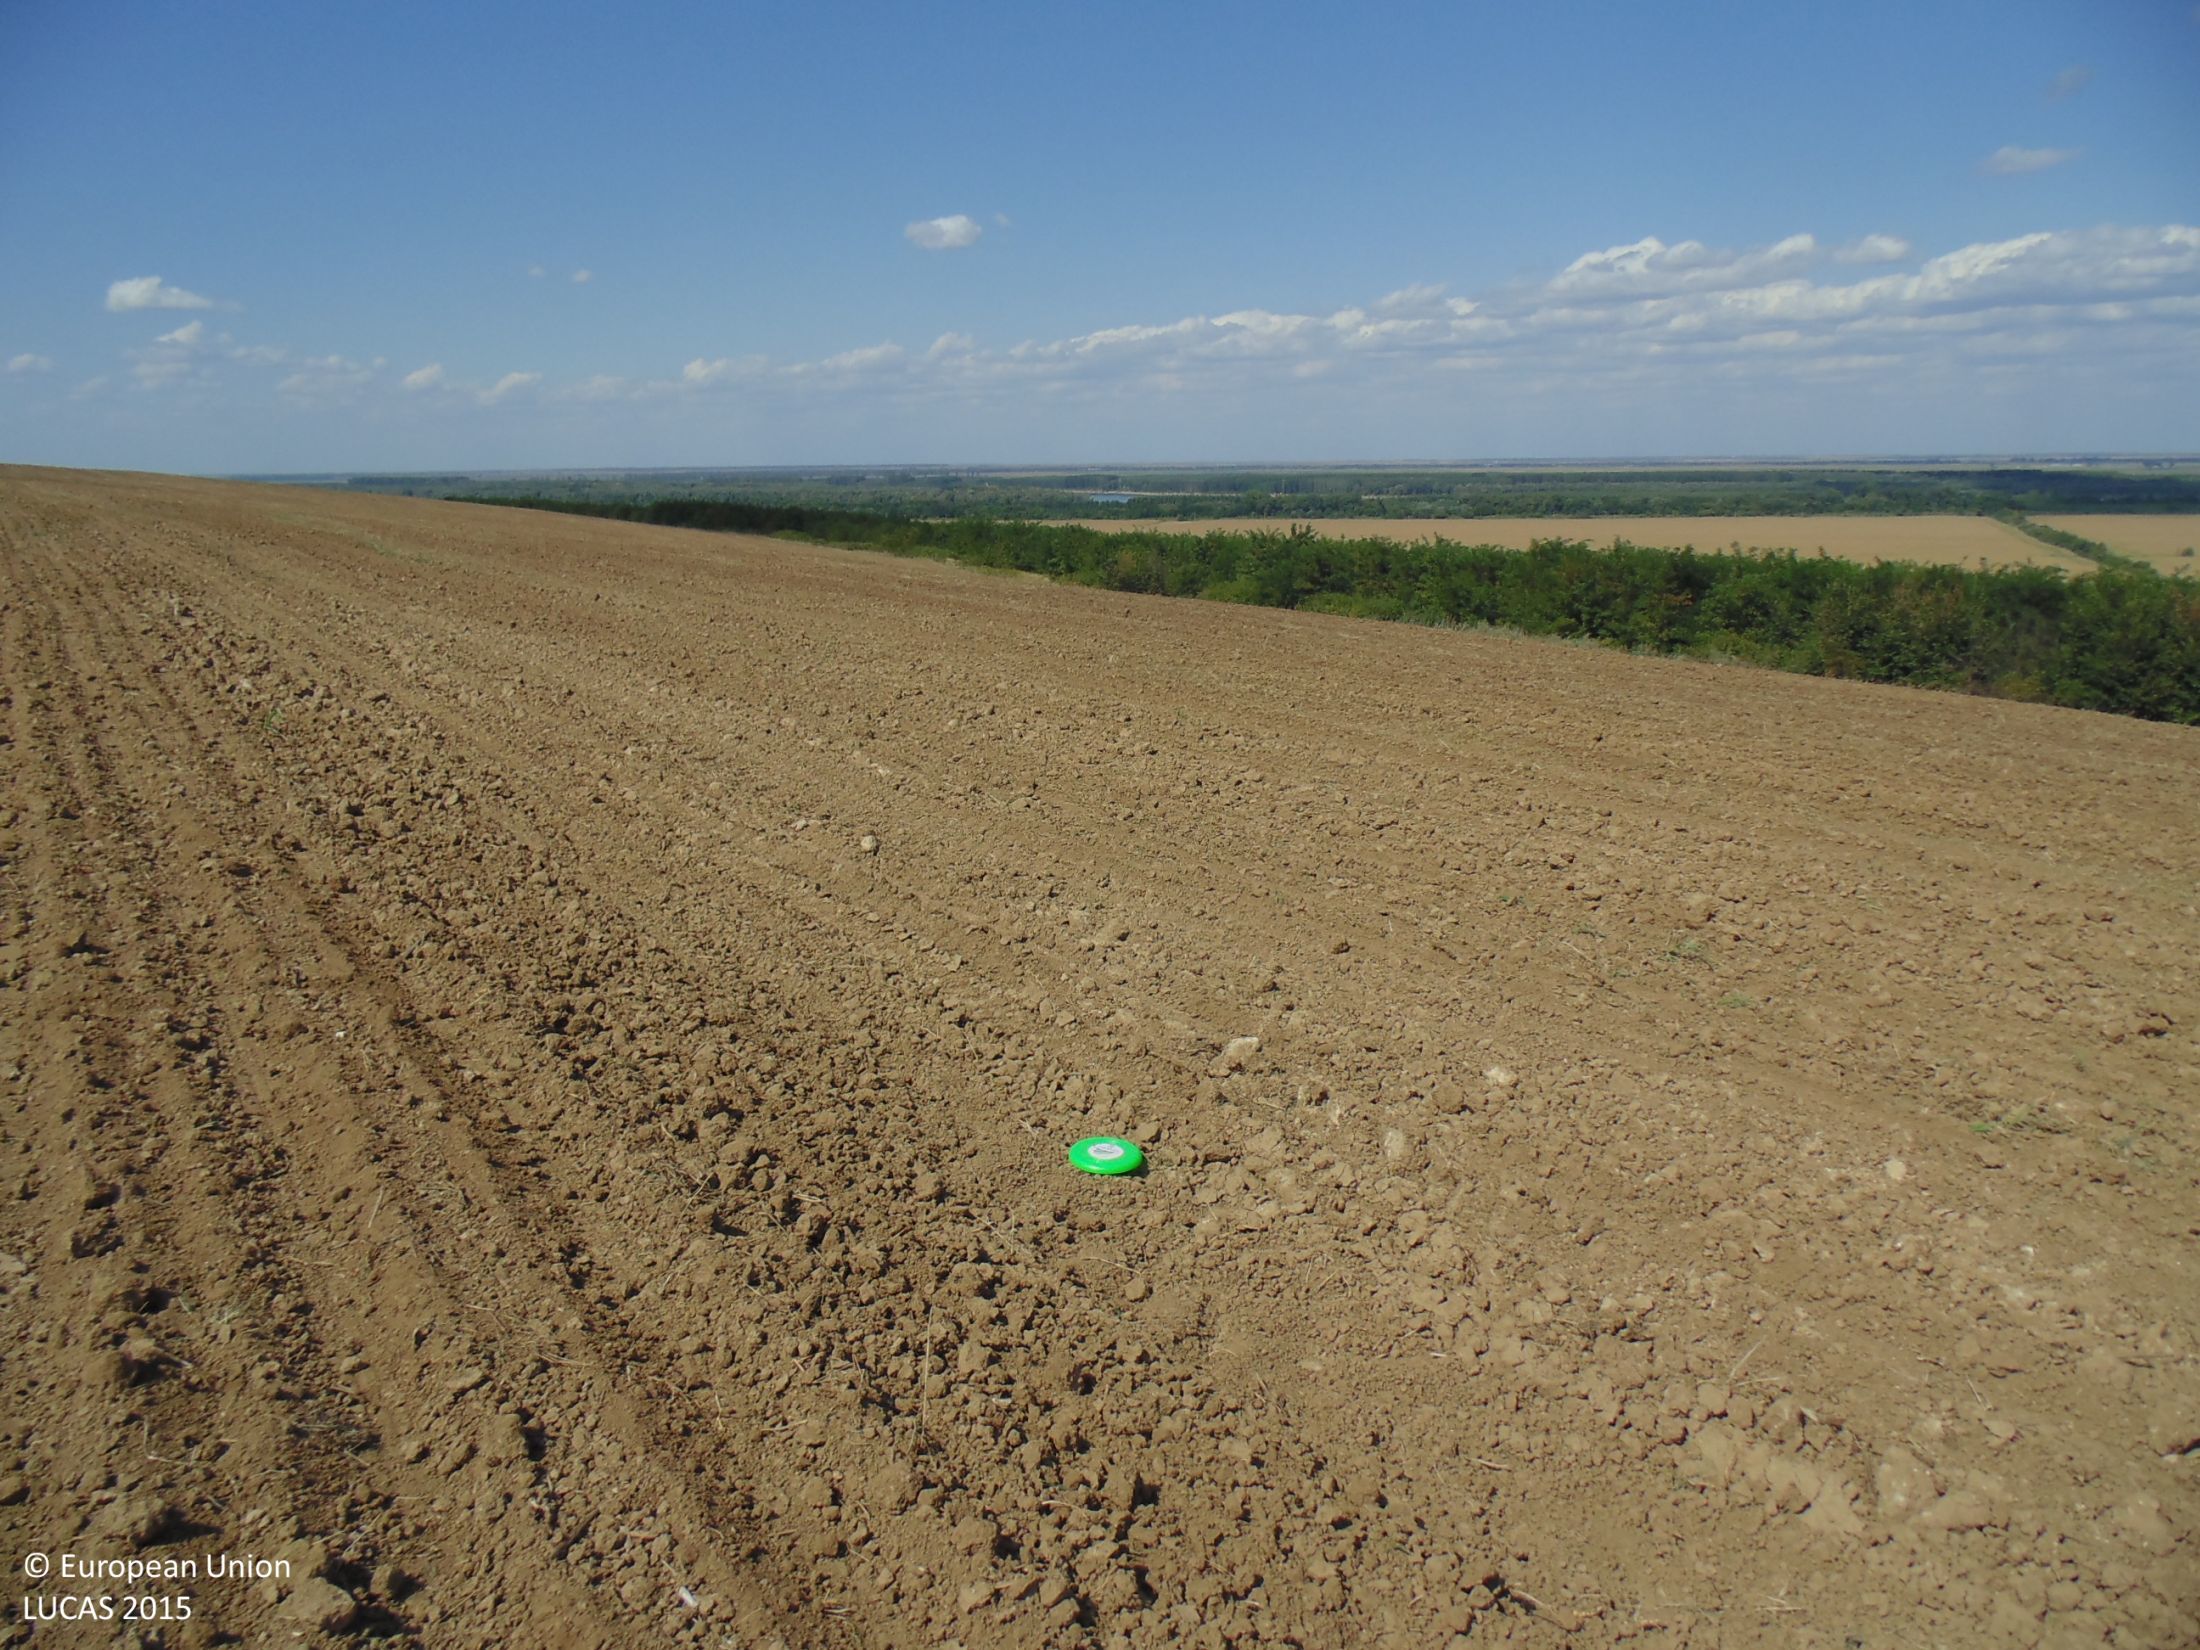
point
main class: Cropland
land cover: Common wheat
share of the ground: < 10 %
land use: Agriculture (excluding fallow land and kitchen gardens)
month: September
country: BG
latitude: 44.1133
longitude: 27.1078
